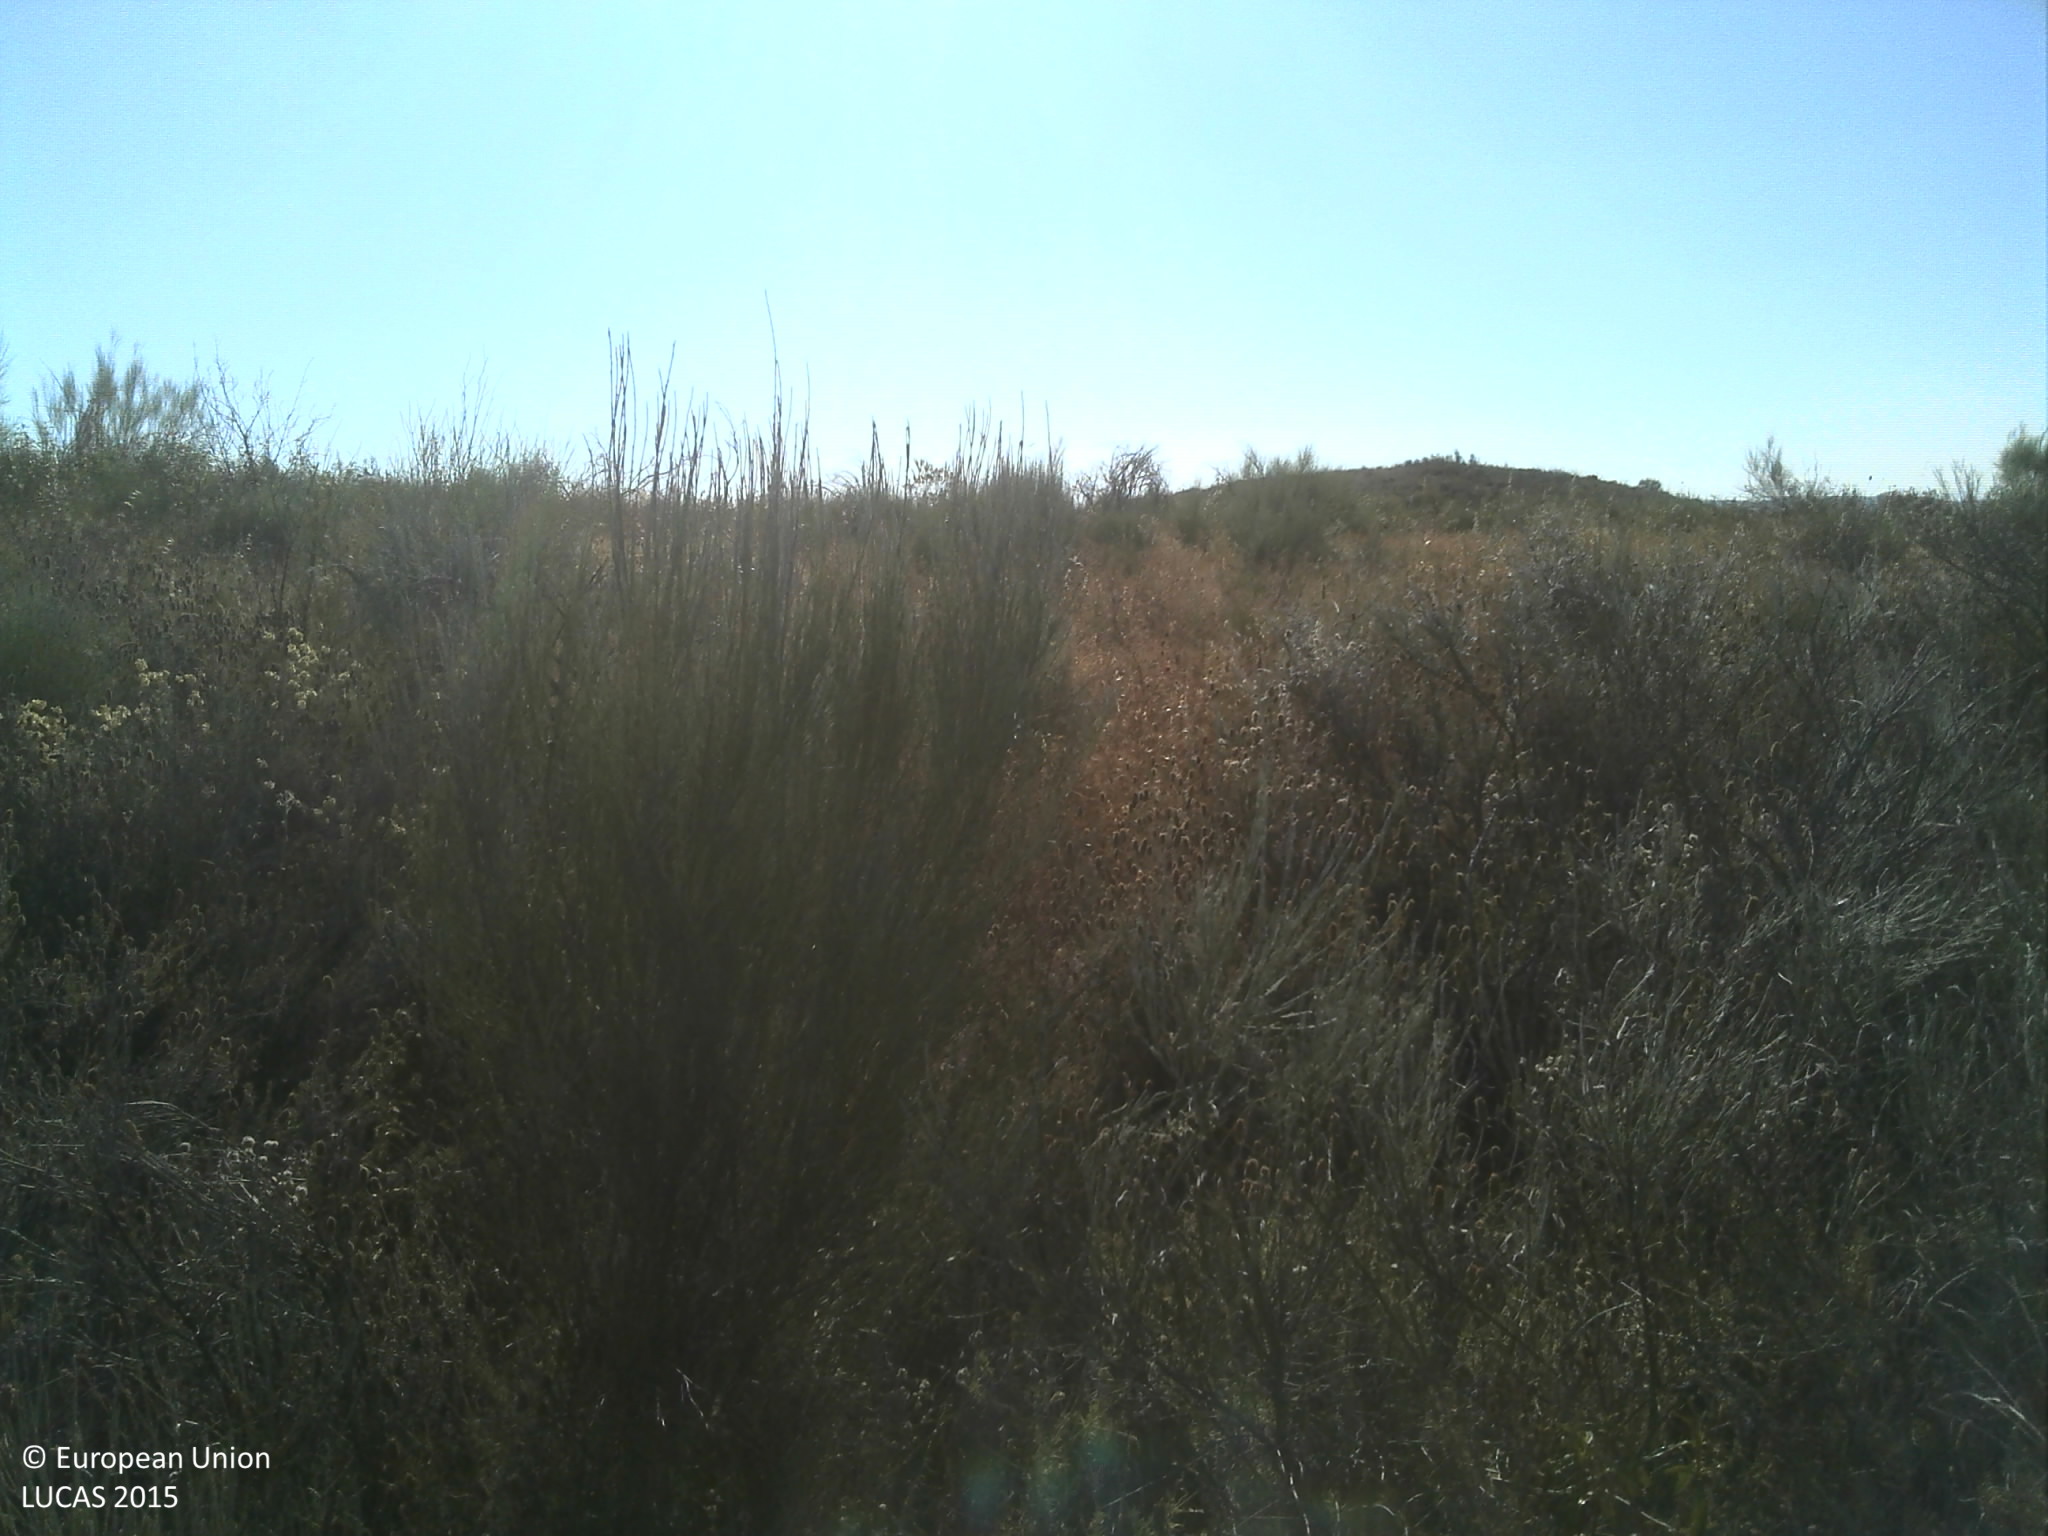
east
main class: Shrubland
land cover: Shrubland without tree cover
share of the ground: > 75 %
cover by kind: shrubs 100 %
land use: Semi-natural and natural areas not in use
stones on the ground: 25 - 50 %
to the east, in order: Shrubland without tree cover; Shrubland with sparse tree cover; Grassland without tree/shrub cover
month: July
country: PT
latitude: 41.0841
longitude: -6.9506
